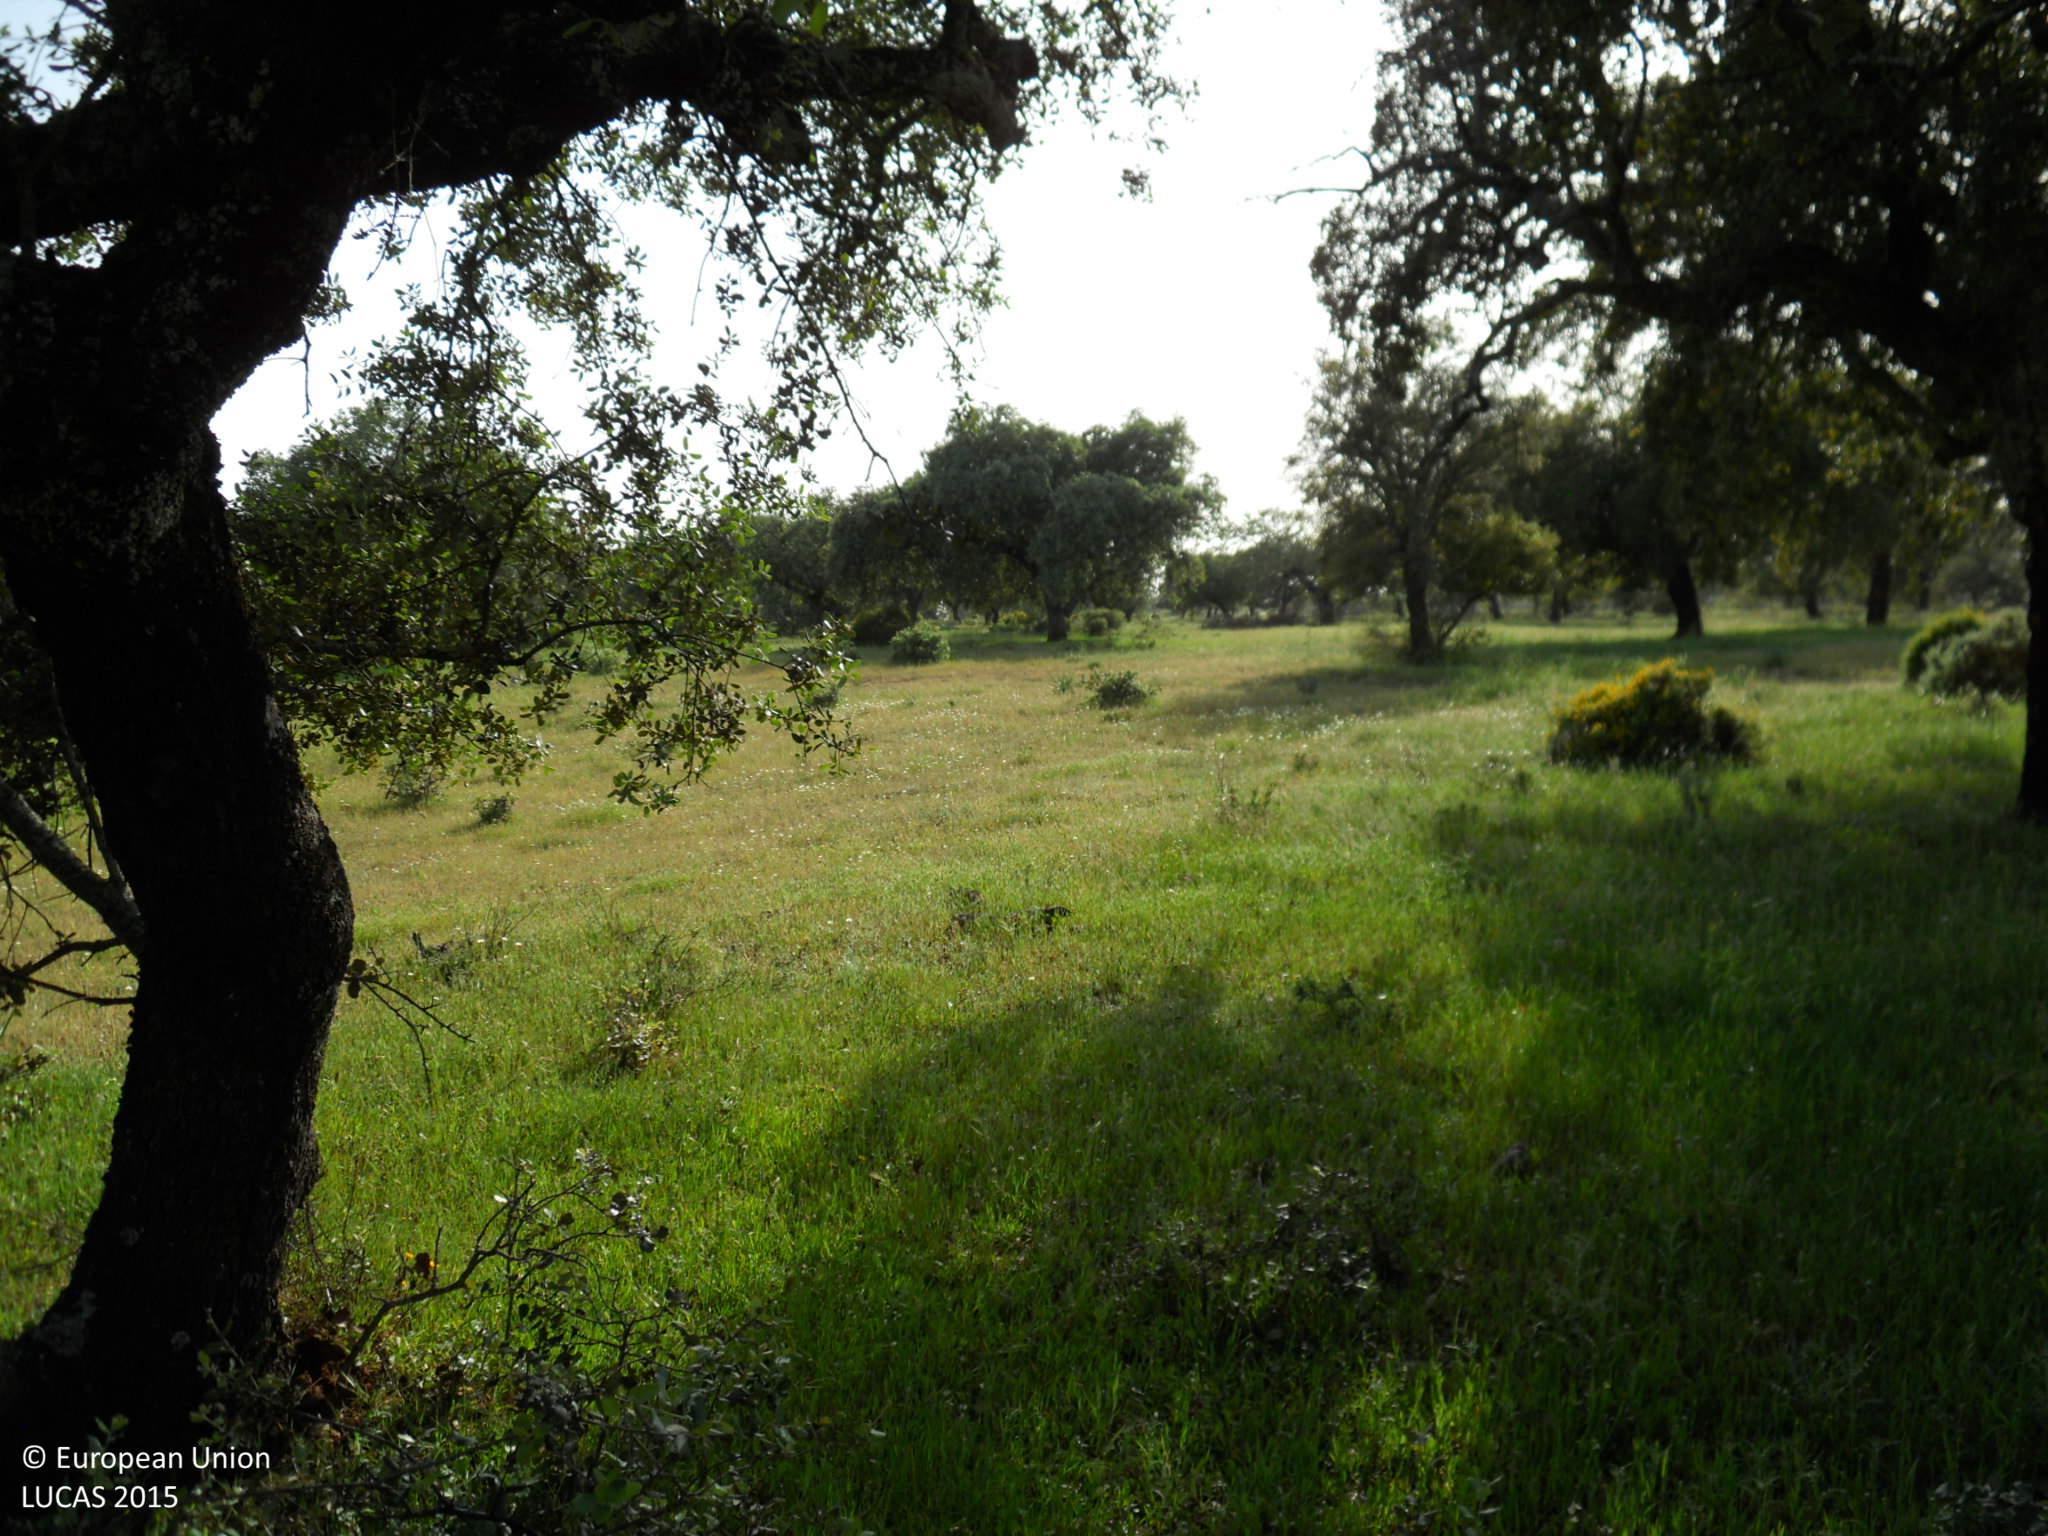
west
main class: Woodland
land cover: Broadleaved woodland
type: broadleaved evergreen forest
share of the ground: 50 - 75 %
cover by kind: broadleaved forest trees 50 %, herbaceous plants 50 %
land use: Forestry
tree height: > 5 m
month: April
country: ES
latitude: 39.0994
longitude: -6.2824
